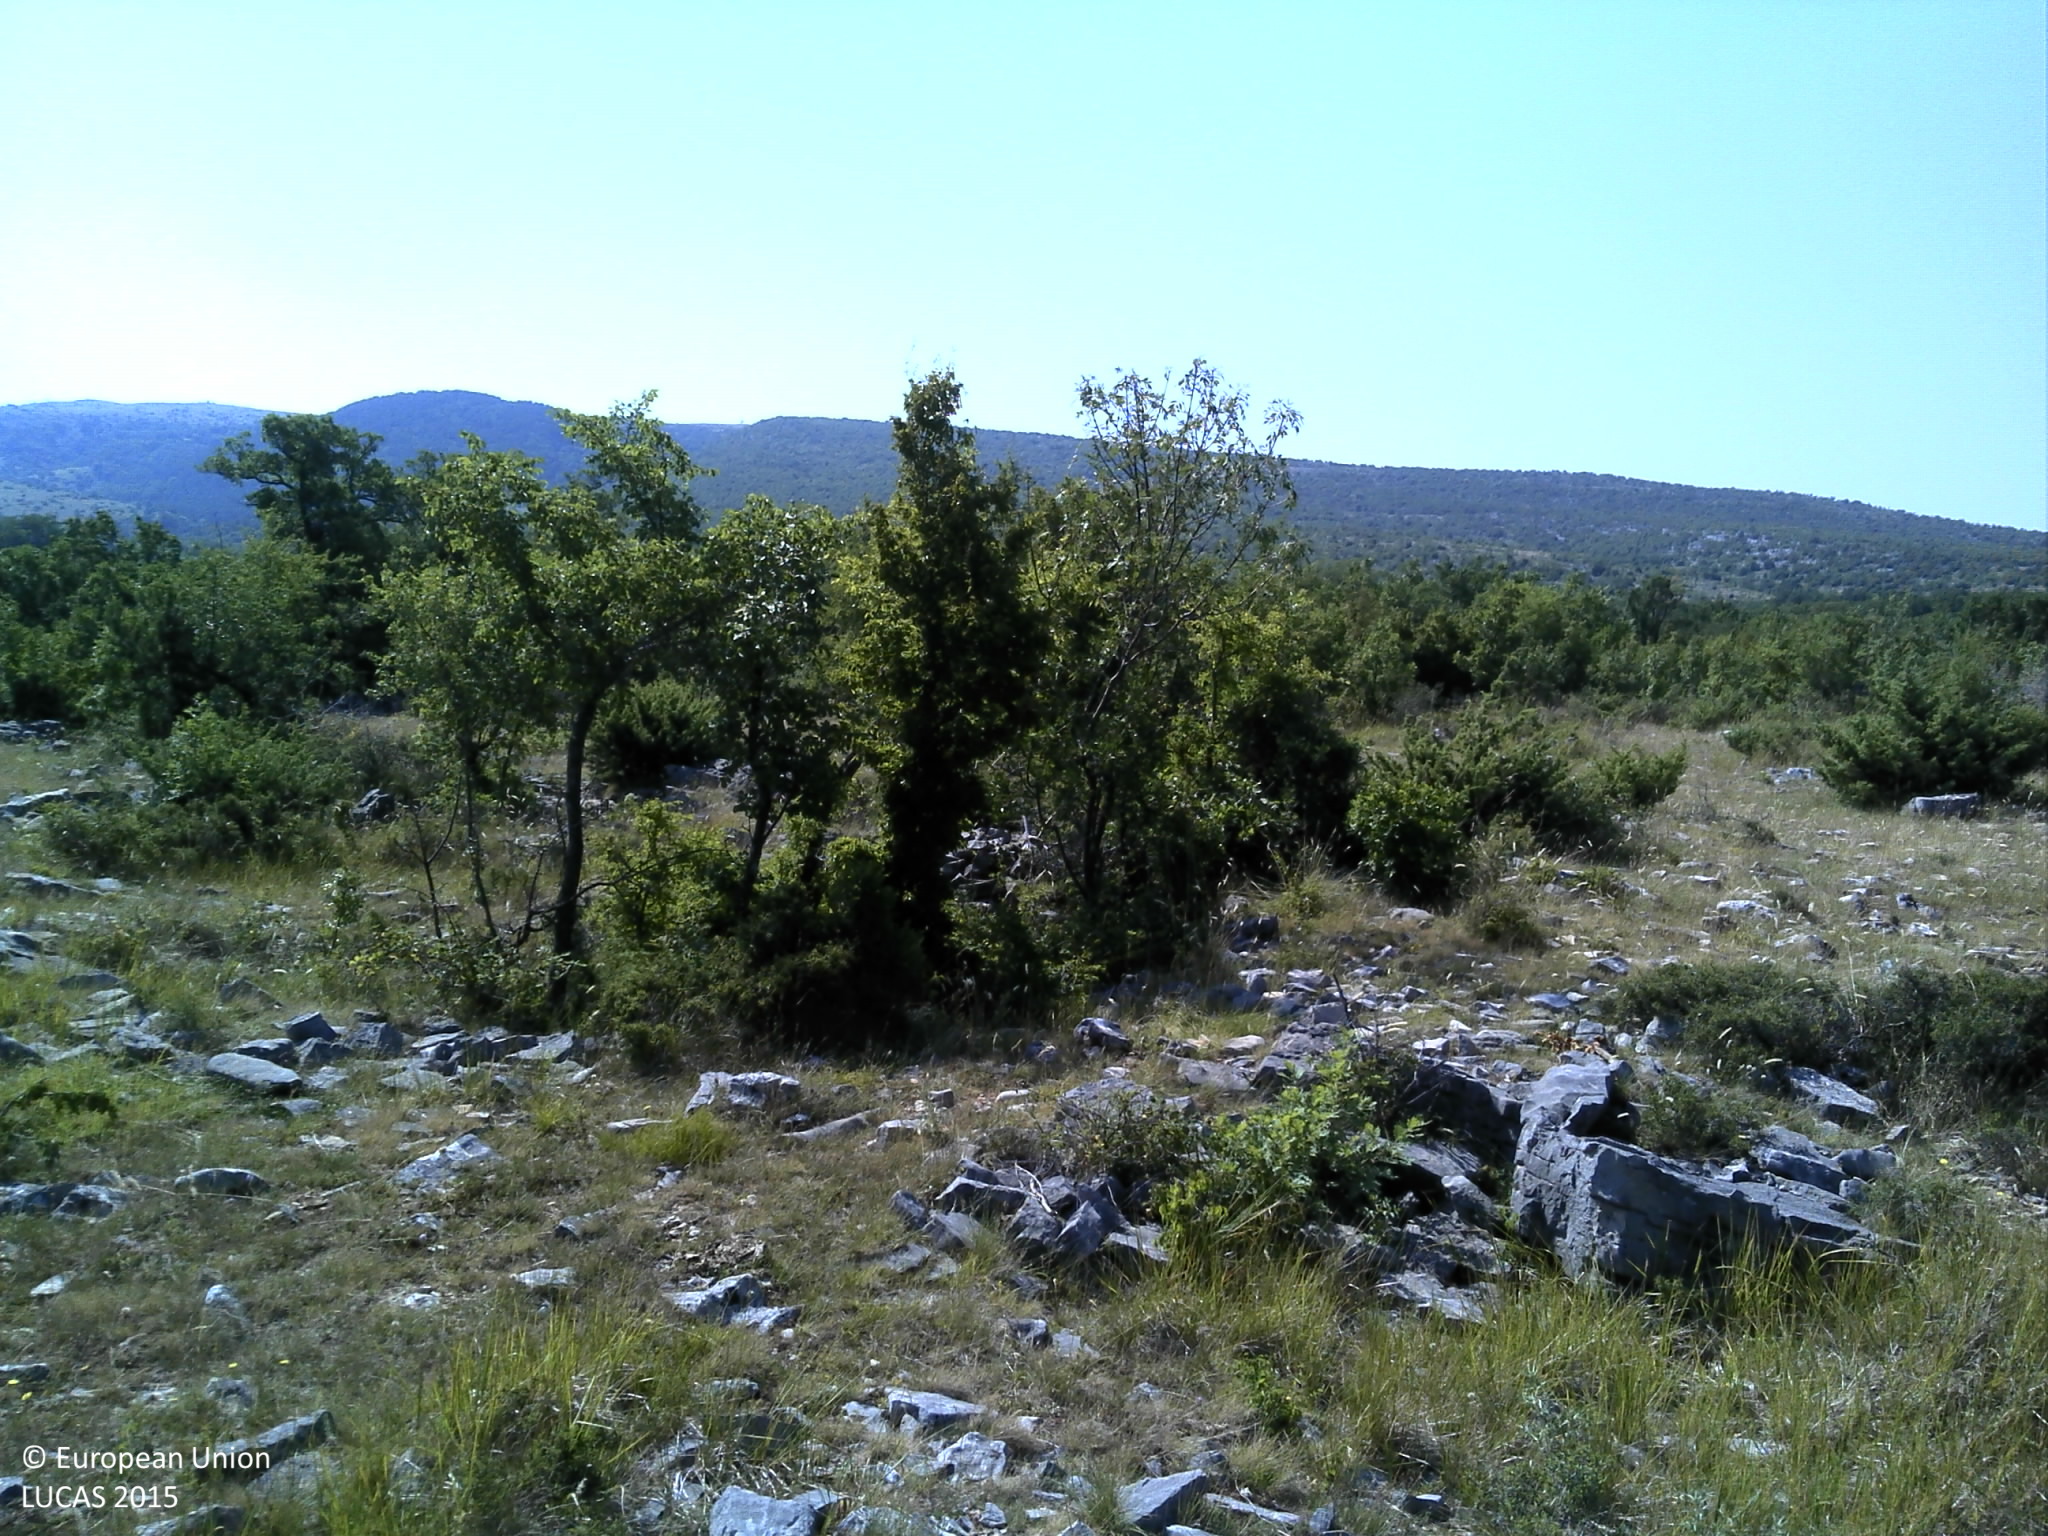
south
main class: Shrubland
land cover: Shrubland with sparse tree cover
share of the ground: 25 - 50 %
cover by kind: shrubs 35 %, consolidated bare surface 25 %, unconsolidated bare surface 25 %, herbaceous plants 10 %, broadleaved forest trees 5 %
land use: Abandoned areas
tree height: > 5 m
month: July
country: HR
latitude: 43.9055
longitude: 16.3049
